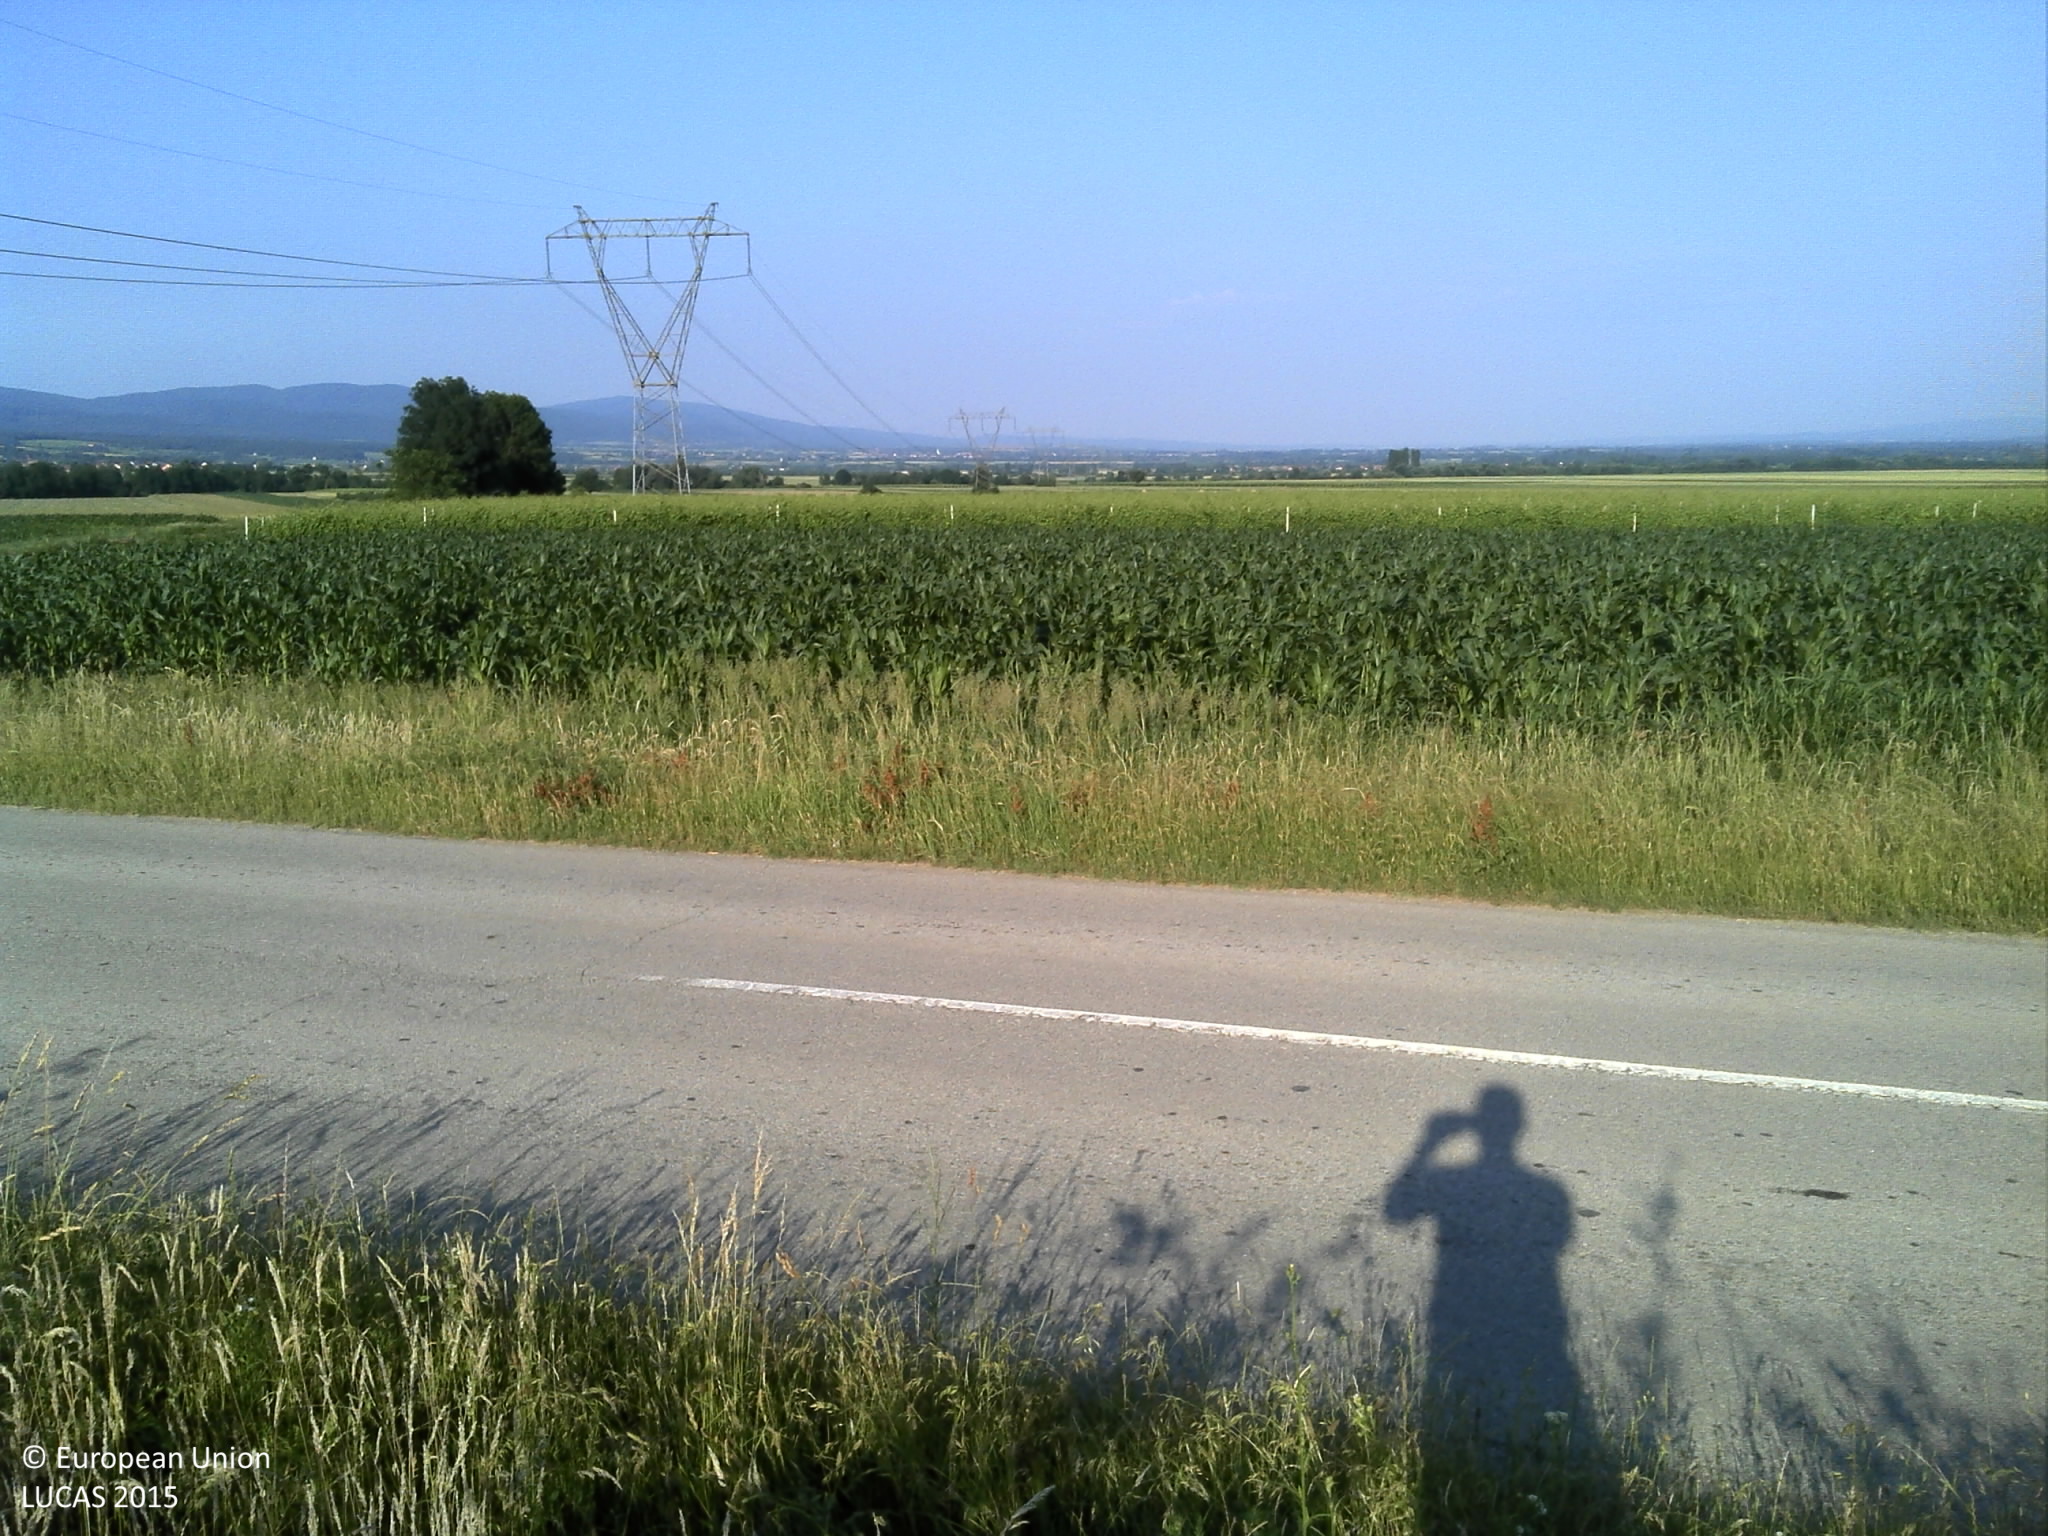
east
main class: Grassland
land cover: Spontaneously vegetated surfaces
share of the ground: > 75 %
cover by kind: herbaceous plants 100 %
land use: Agriculture (excluding fallow land and kitchen gardens)
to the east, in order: Shruby margins; Spontaneously vegetated surfaces; Grass margins; Tracks; Grass margins; Maize; Vineyards
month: June
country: HR
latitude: 45.4288
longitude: 17.6067
